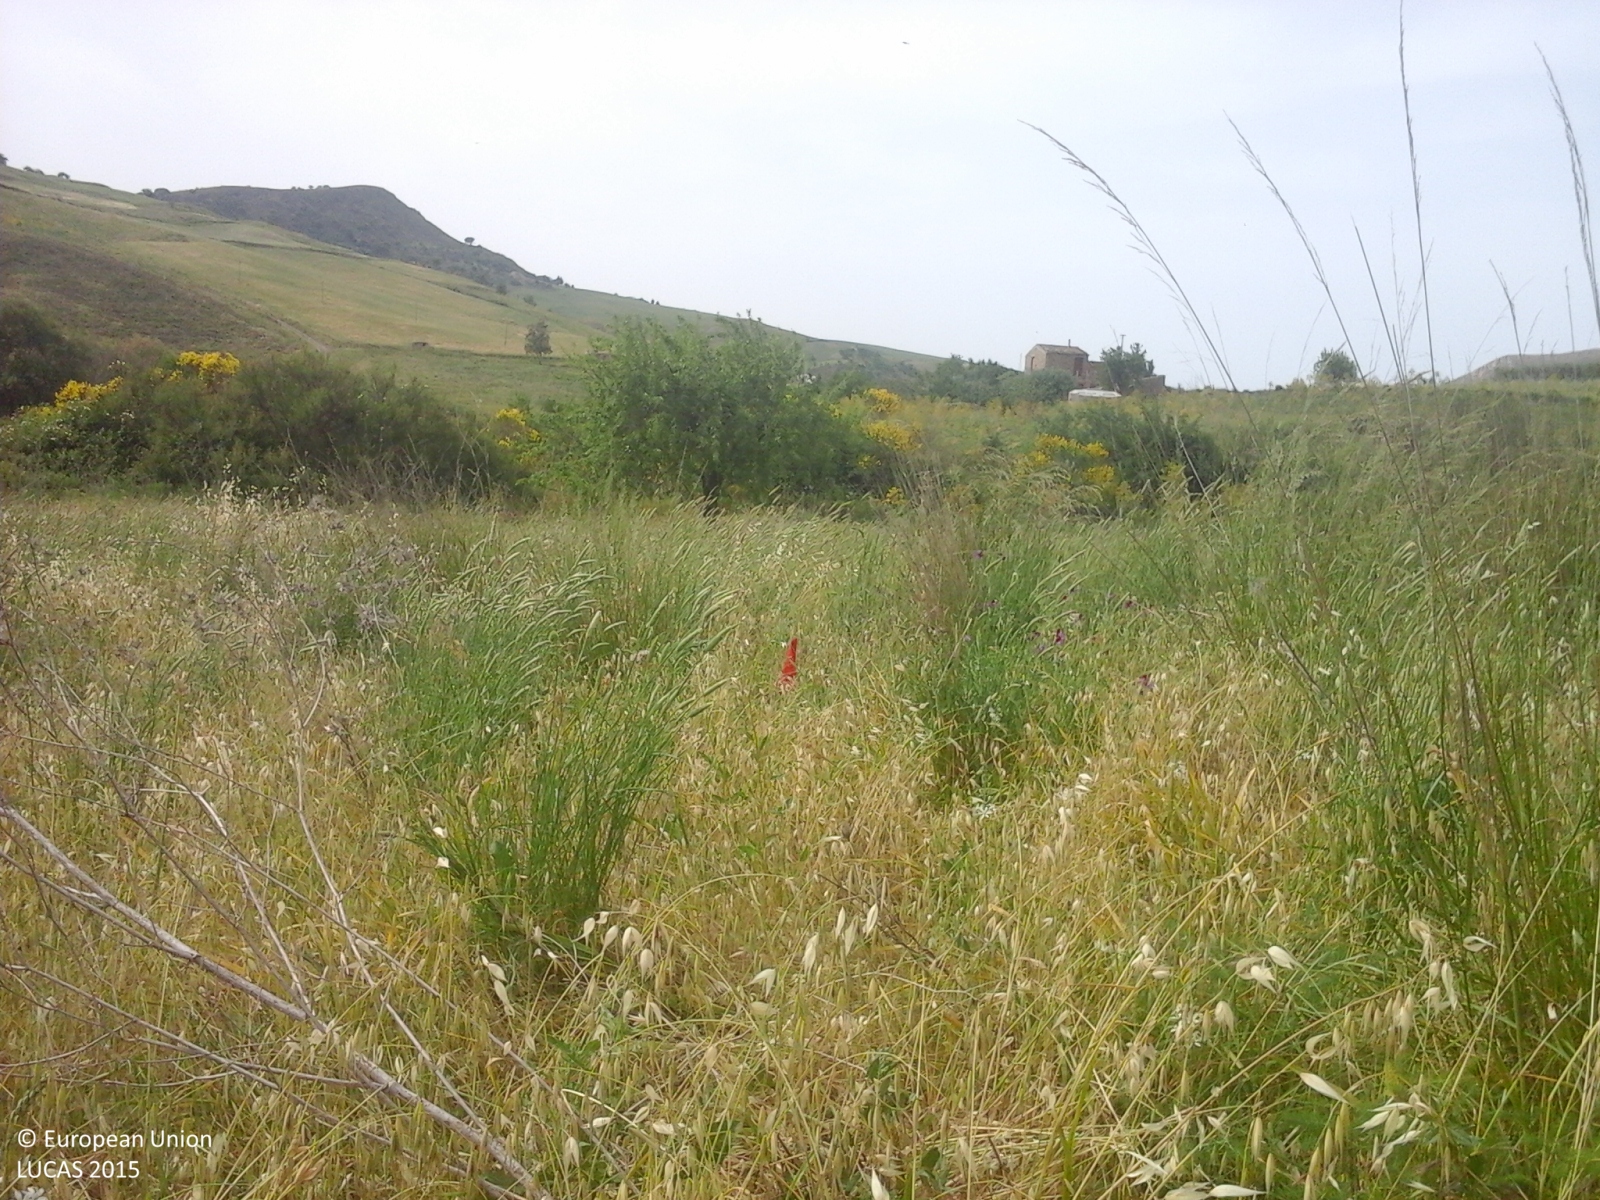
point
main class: Grassland
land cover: Spontaneously vegetated surfaces
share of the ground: > 75 %
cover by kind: herbaceous plants 100 %
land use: Fallow land
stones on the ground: < 10 %
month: May
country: IT
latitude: 37.7455
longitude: 14.2030
